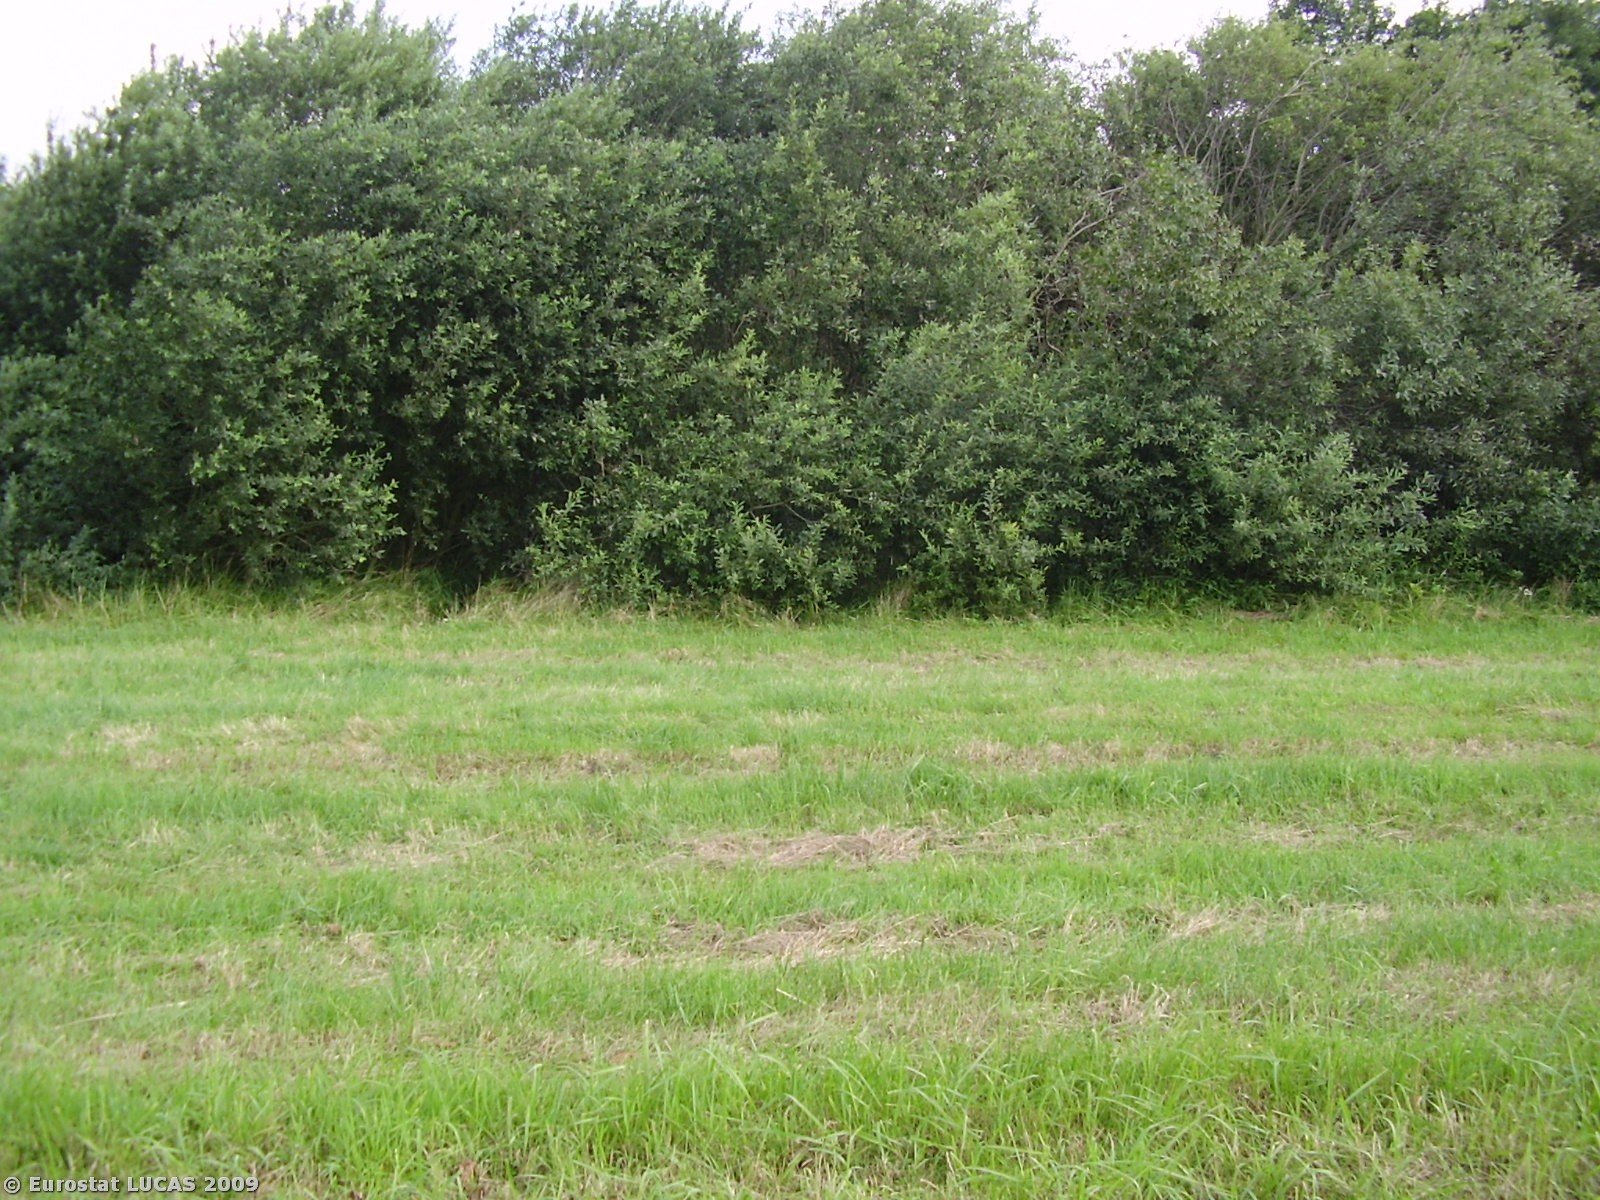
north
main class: Cropland
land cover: Common wheat
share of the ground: > 75 %
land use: Agriculture (excluding fallow land and kitchen gardens)
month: May
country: PL
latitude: 51.5118
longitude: 16.8538
